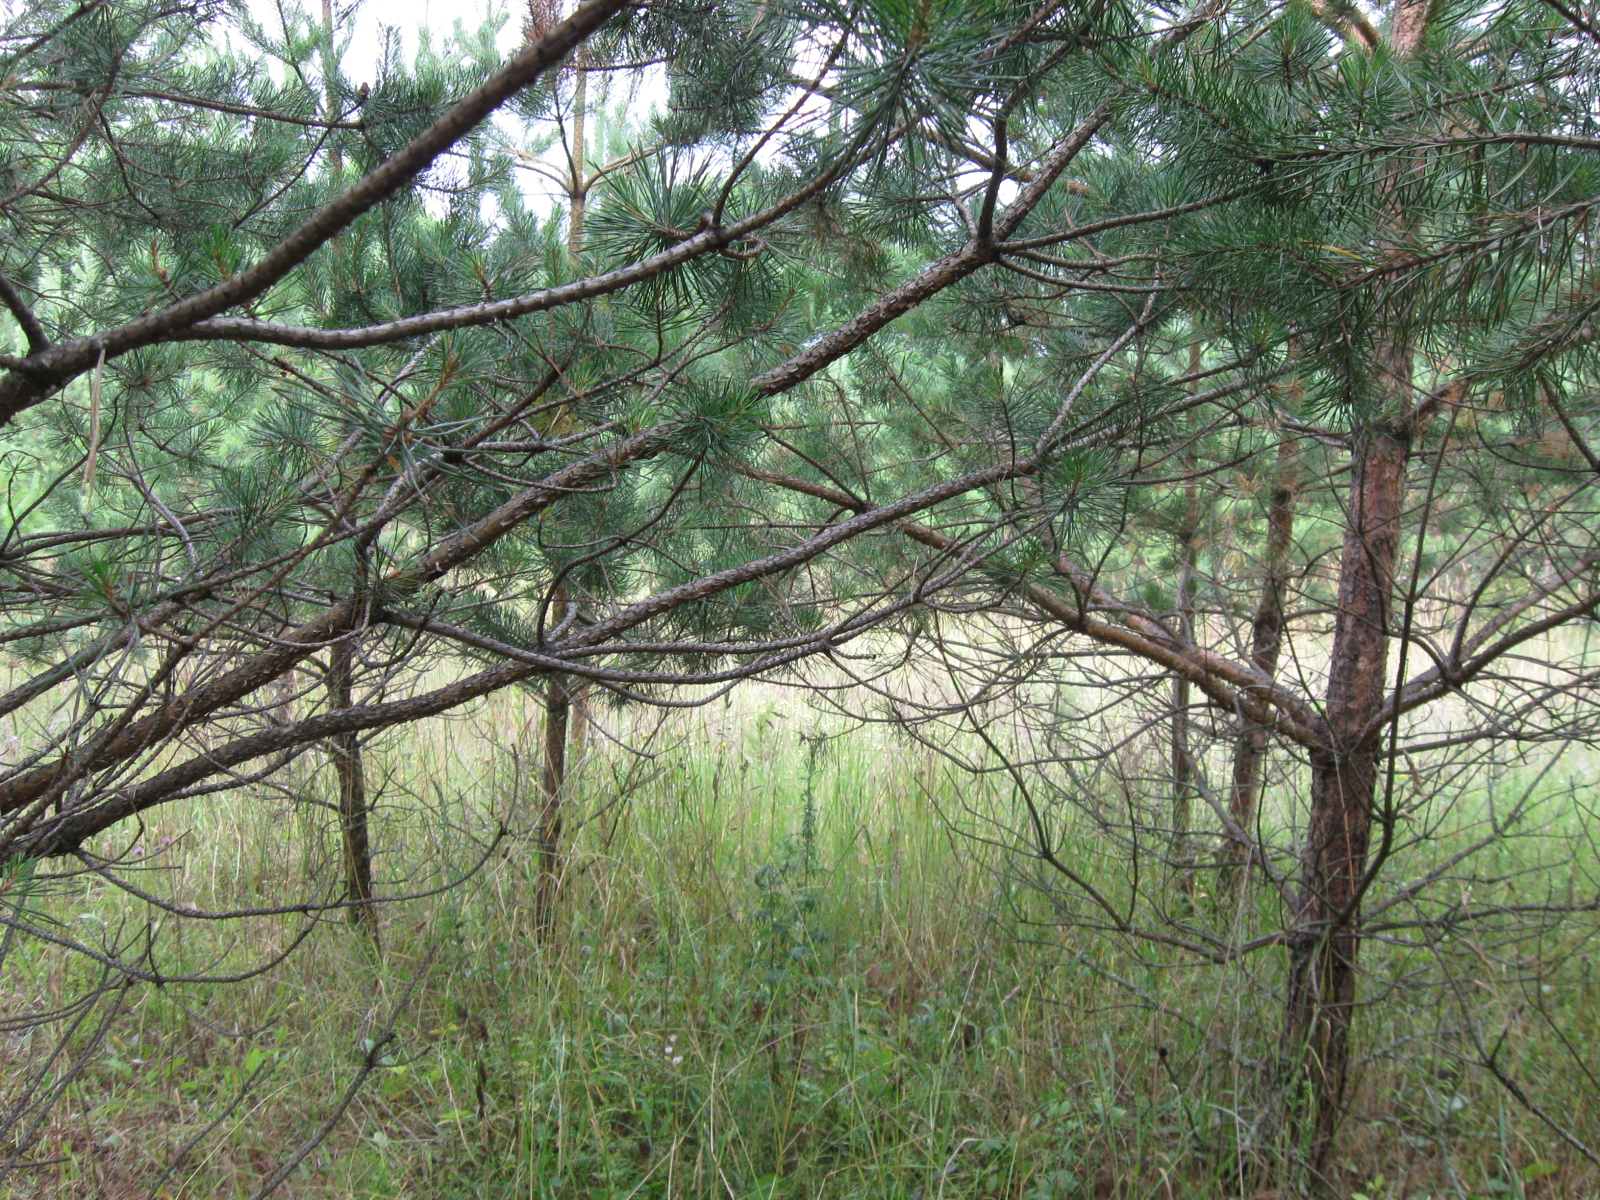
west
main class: Woodland
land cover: Pine dominated coniferous woodland
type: hemiboreal forest and nemoral coniferous forest and mixed broadleaved-coniferous forest
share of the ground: 50 - 75 %
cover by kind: coniferous forest trees 70 %, herbaceous plants 25 %, unconsolidated bare surface 5 %
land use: Forestry
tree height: < 5 m
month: July
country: LT
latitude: 54.4058
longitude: 24.3504
